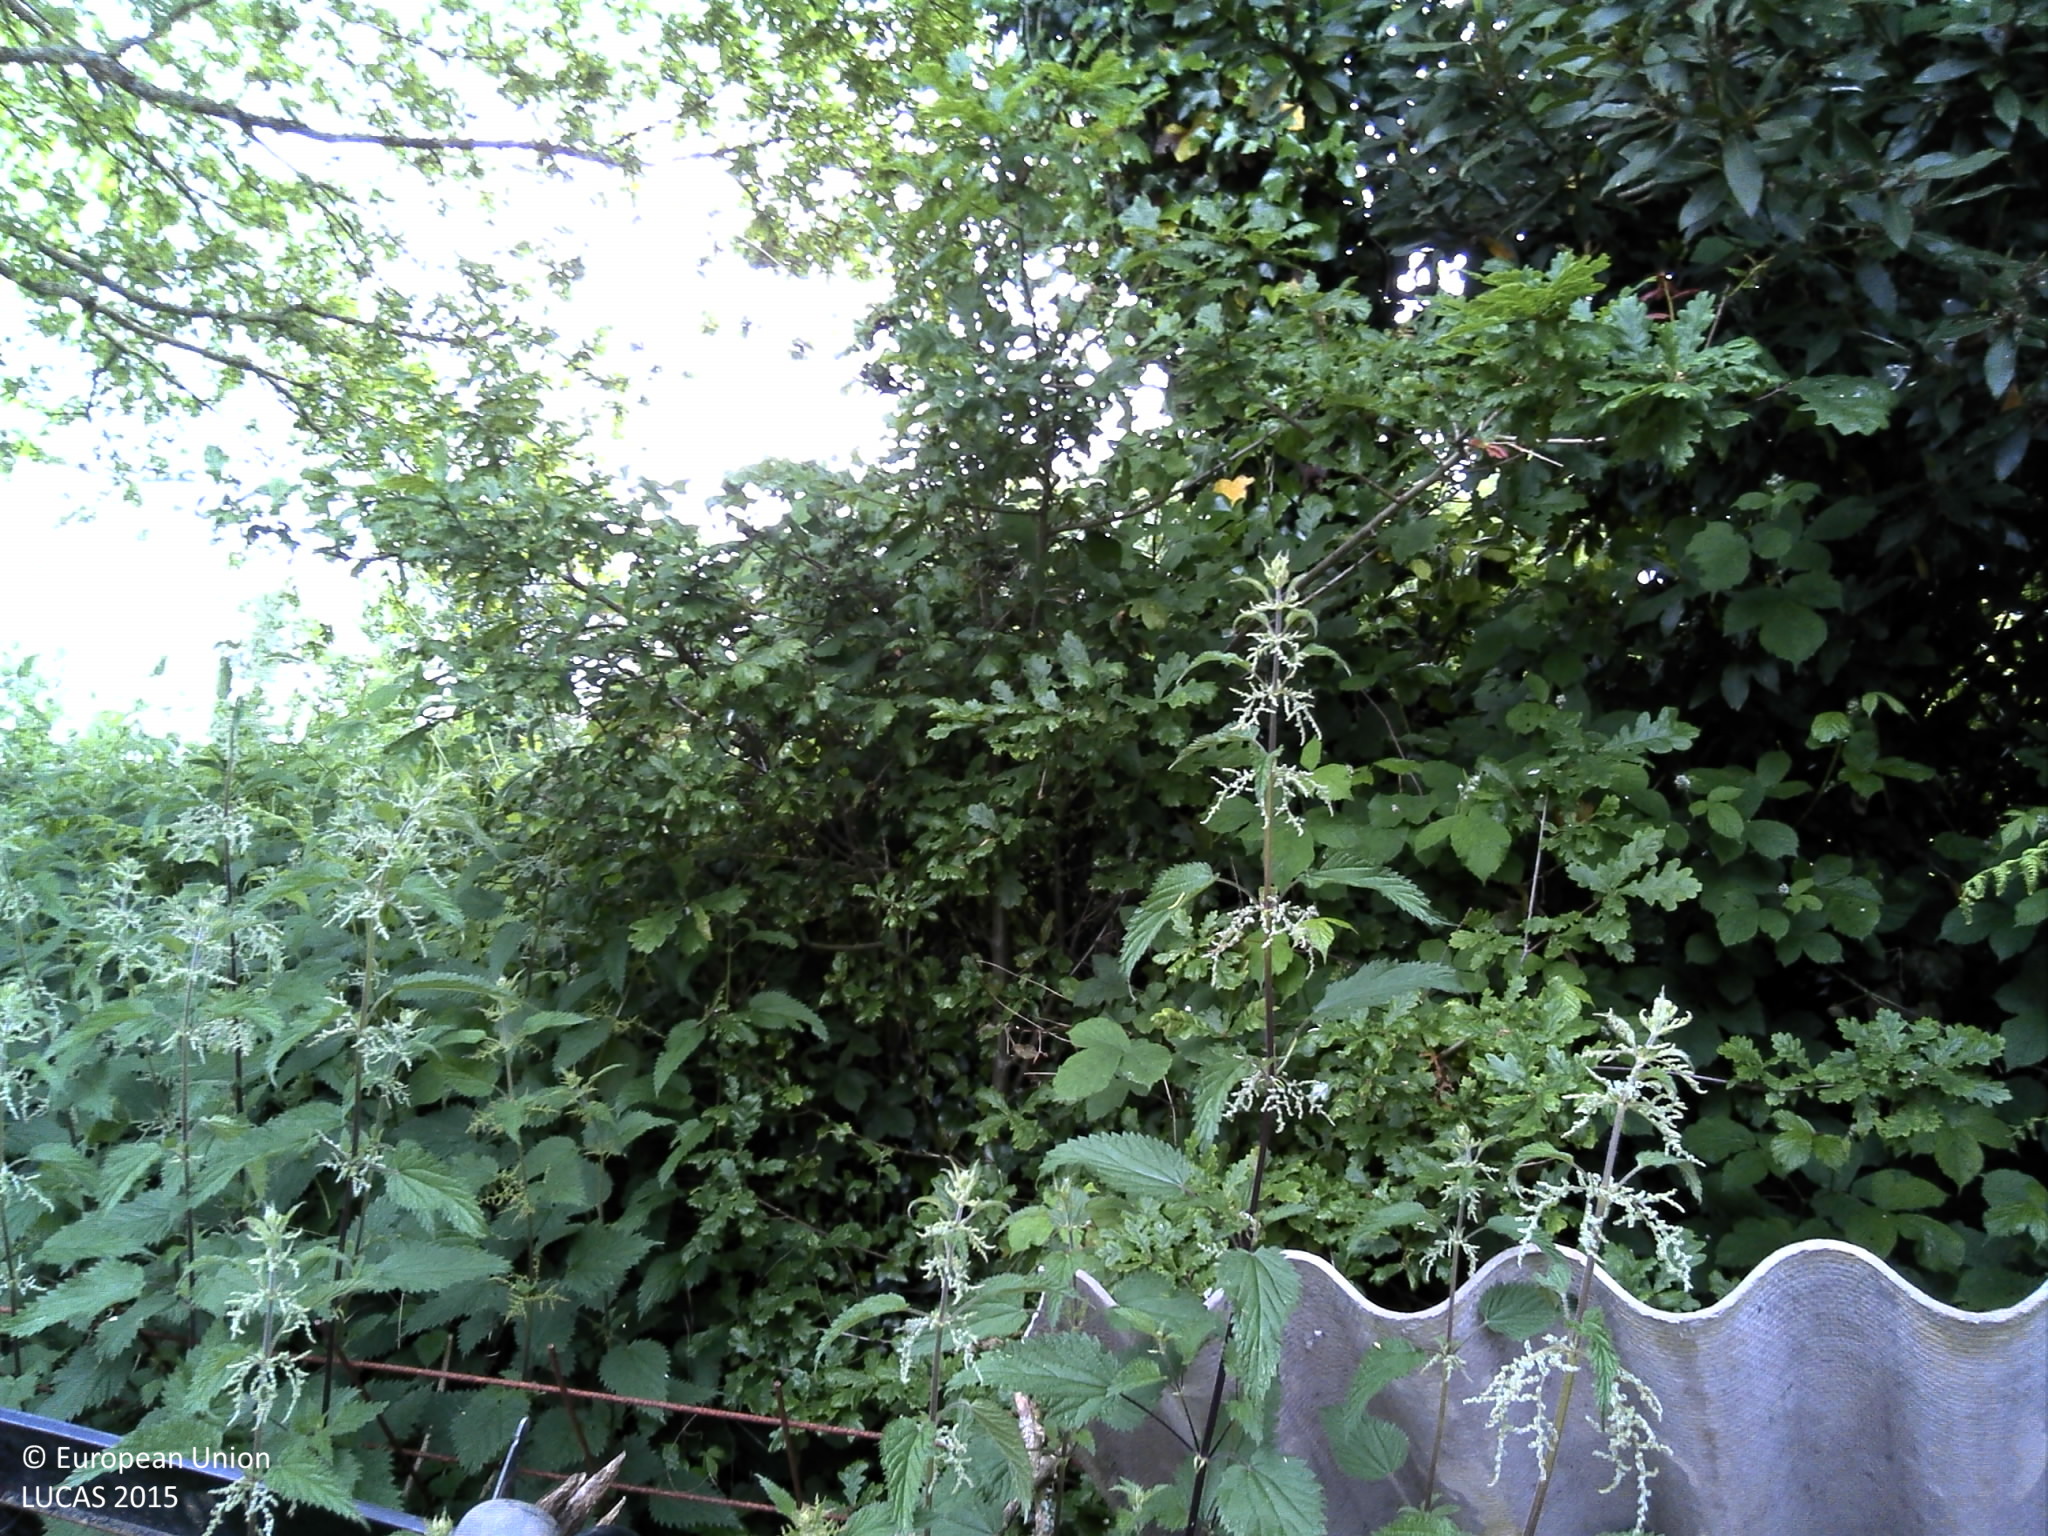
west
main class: Grassland
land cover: Grassland without tree/shrub cover
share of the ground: > 75 %
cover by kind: herbaceous plants 100 %
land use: Residential
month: June
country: FR
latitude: 47.9399
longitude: -3.6127
